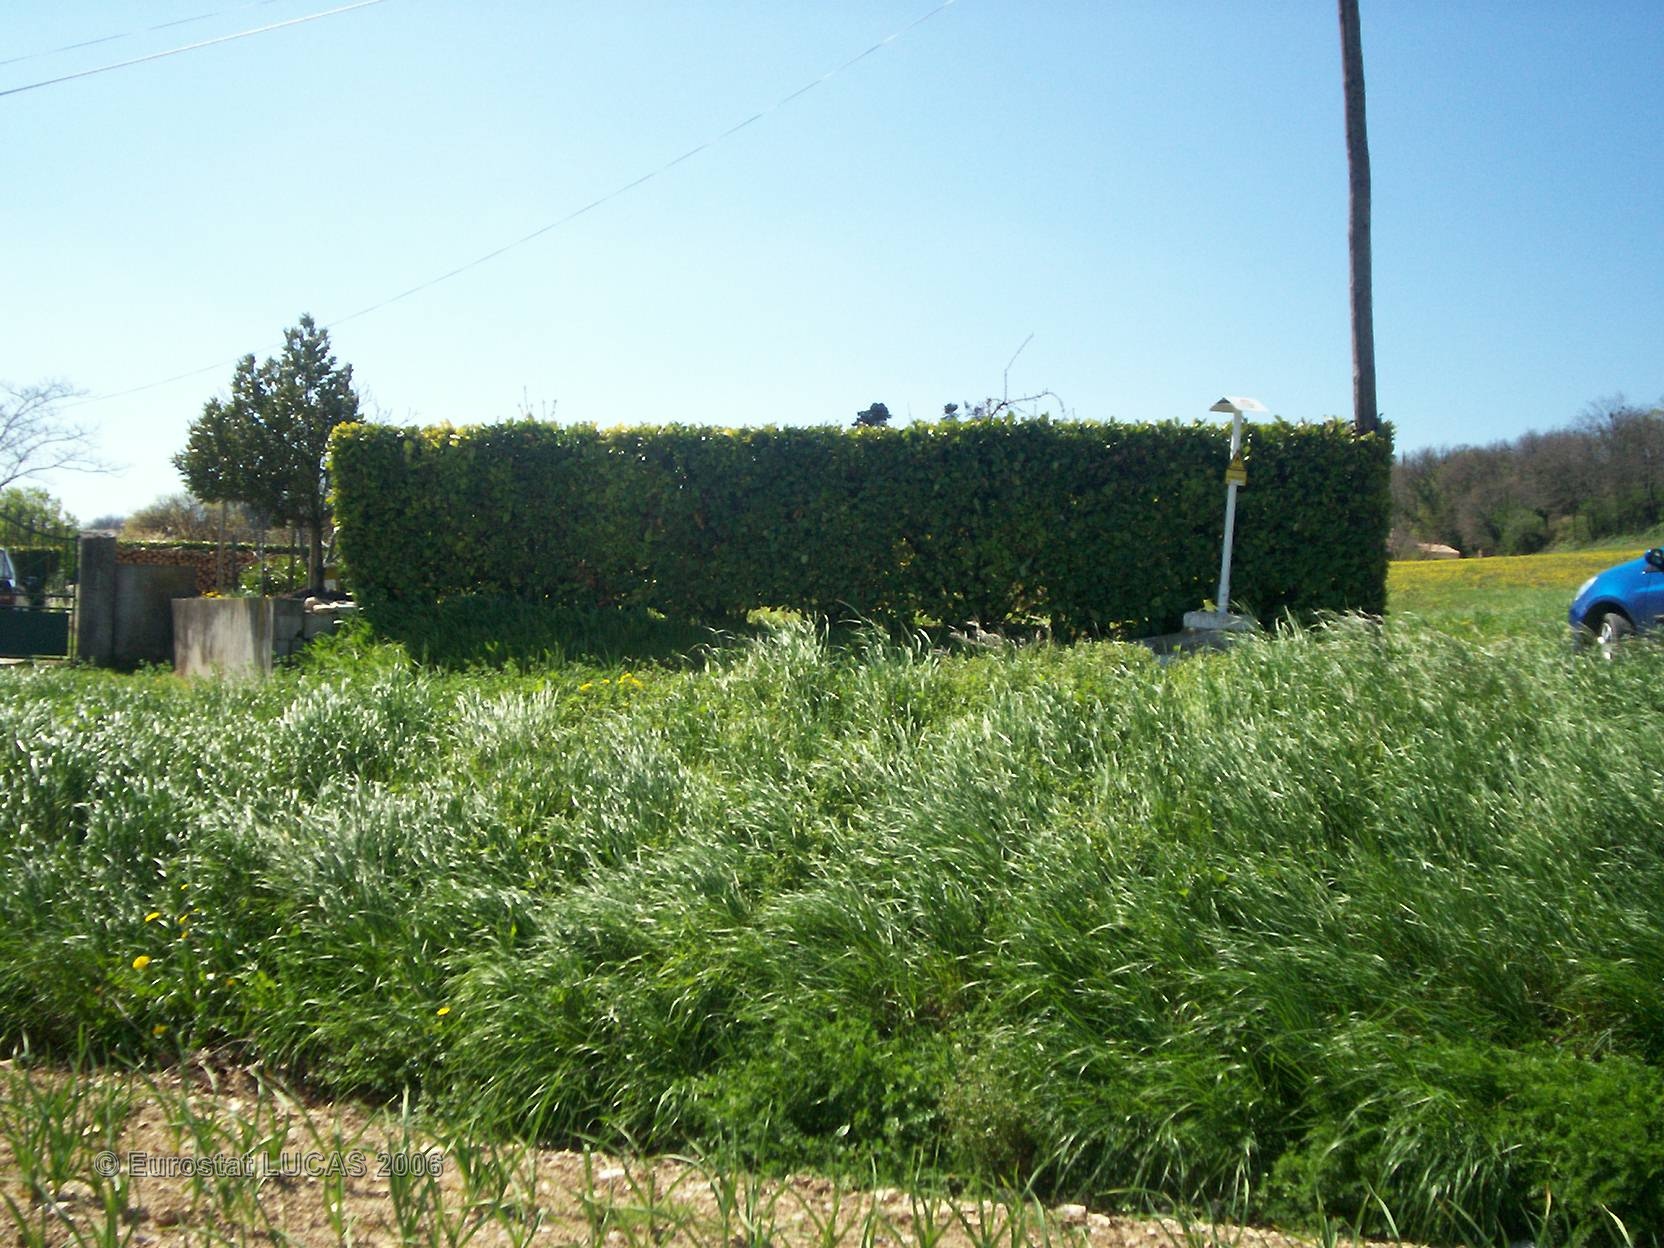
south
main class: Cropland
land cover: Other fresh vegetables
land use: Agriculture (excluding fallow land and kitchen gardens)
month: April
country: FR
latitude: 44.7319
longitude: 4.9176
